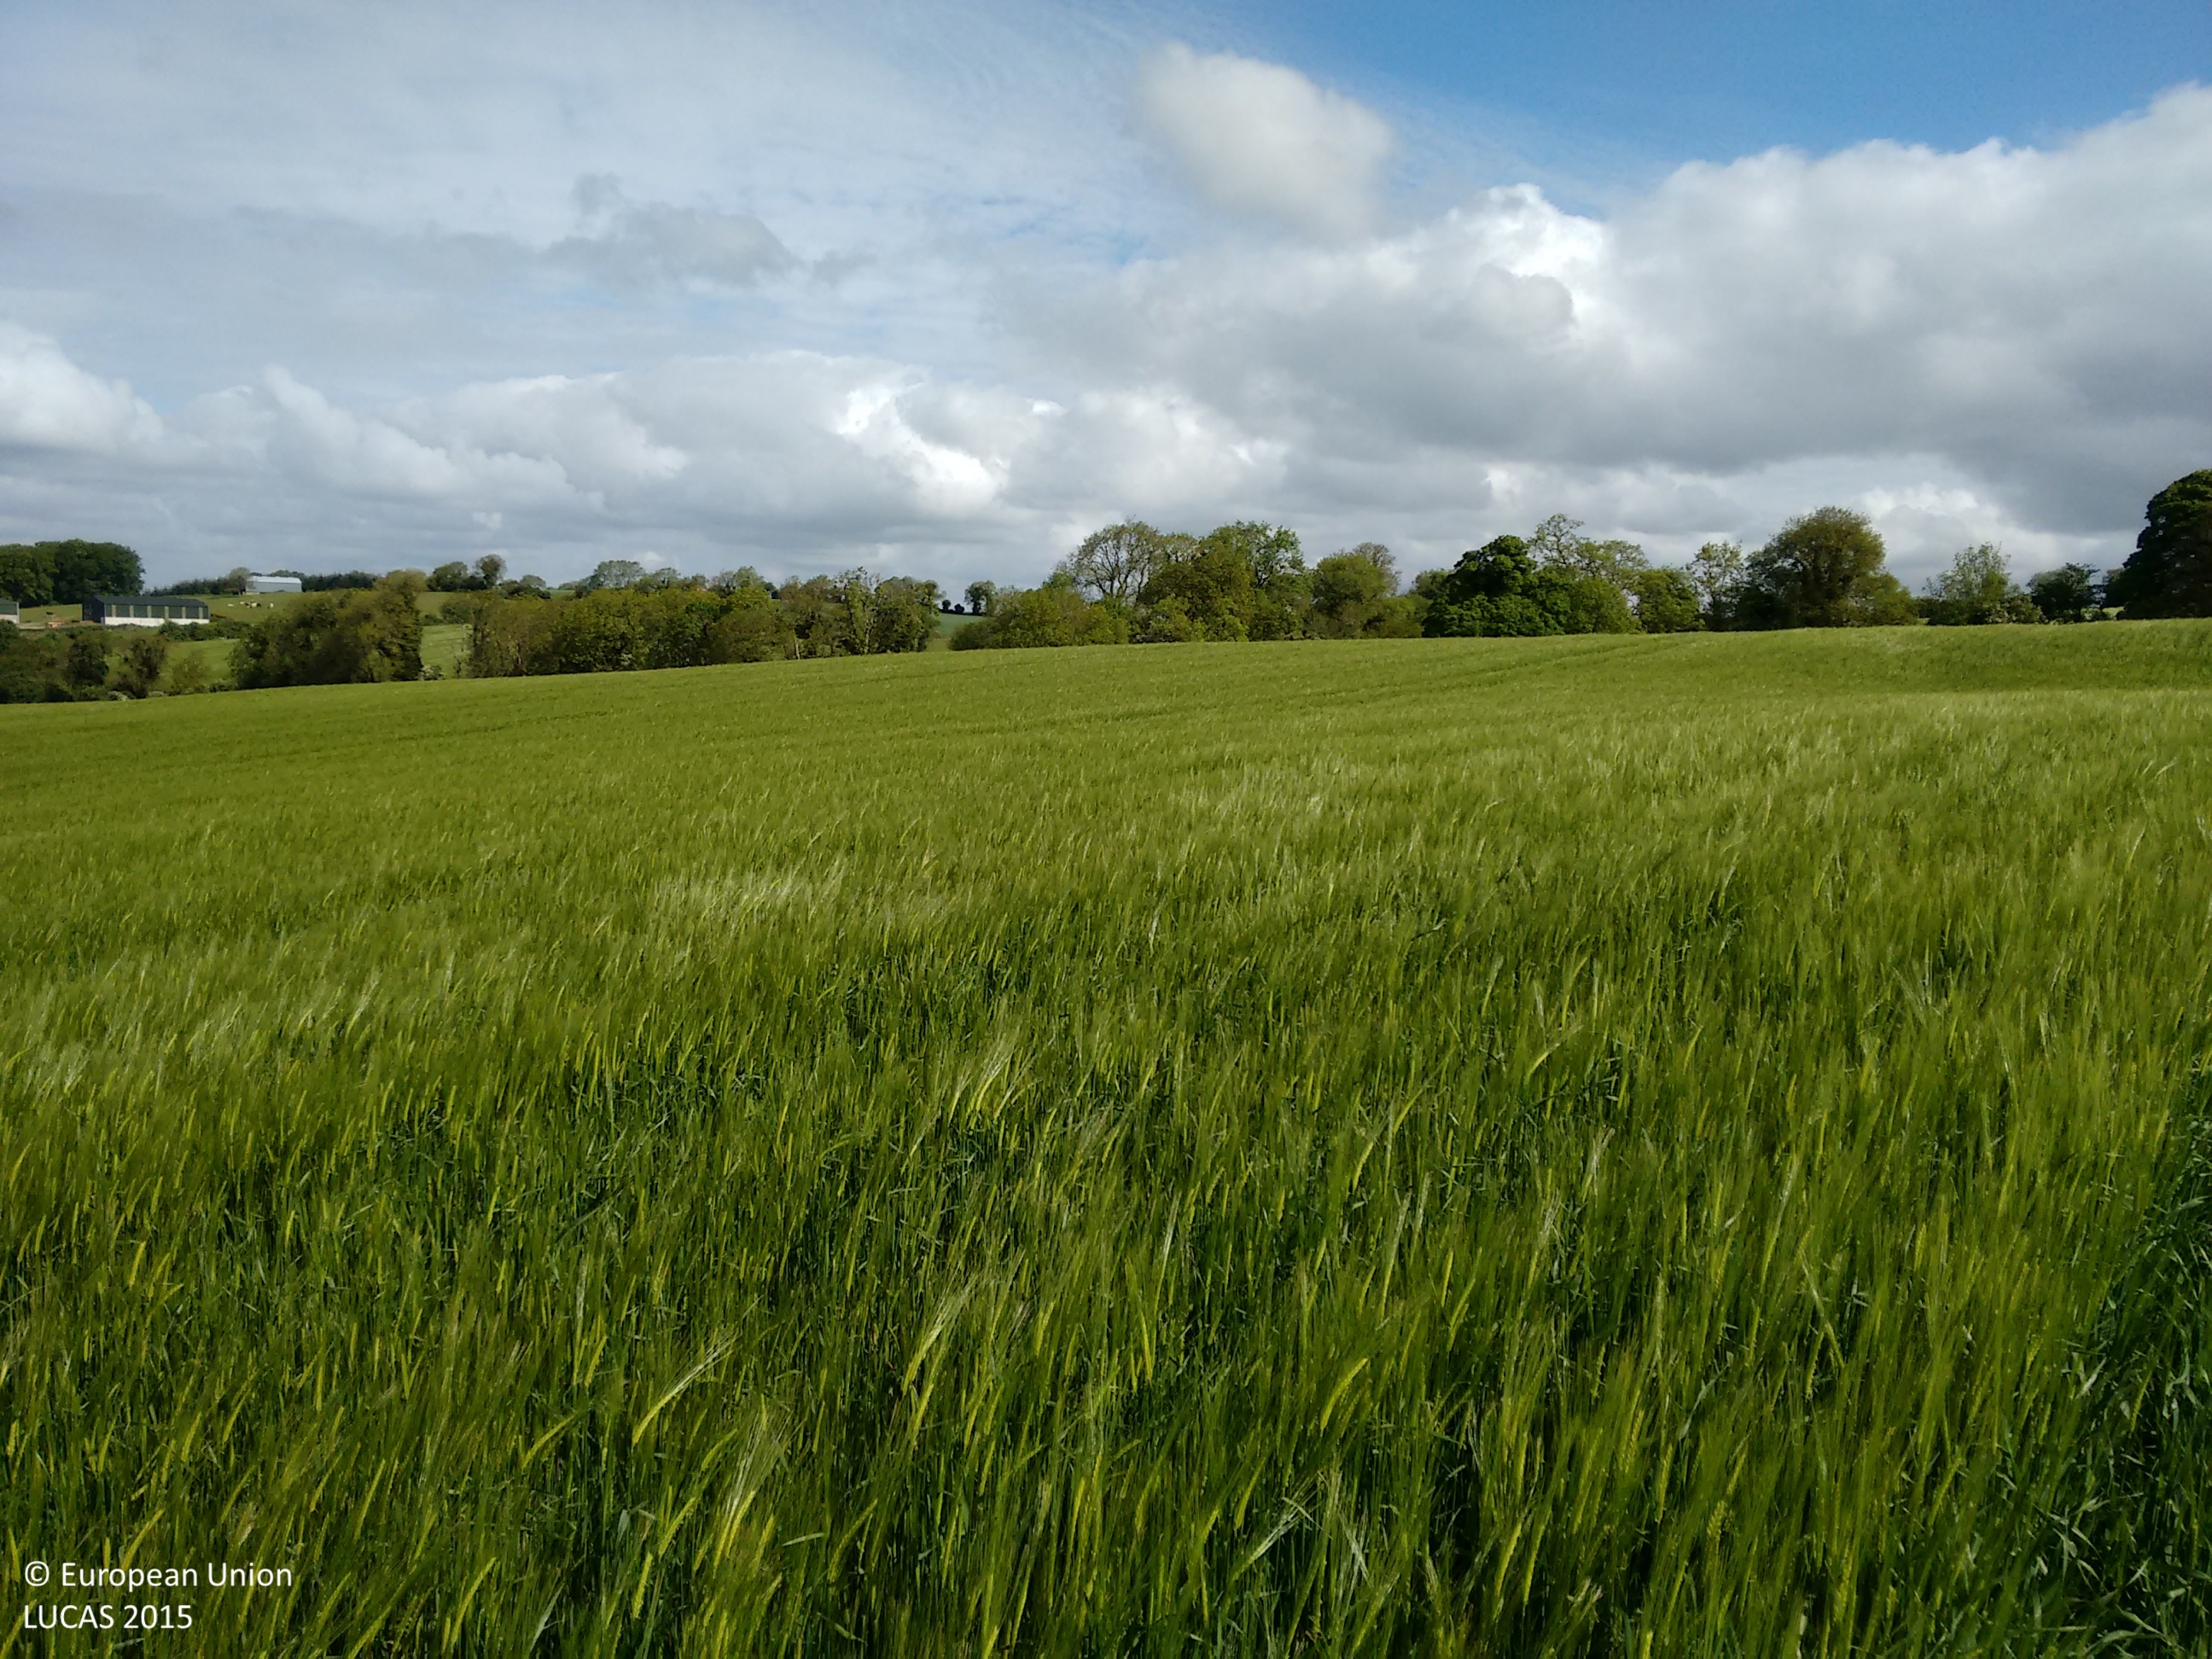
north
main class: Cropland
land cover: Common wheat
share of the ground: > 75 %
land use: Agriculture (excluding fallow land and kitchen gardens)
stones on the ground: < 10 %
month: June
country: IE
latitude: 53.1852
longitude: -6.5756
